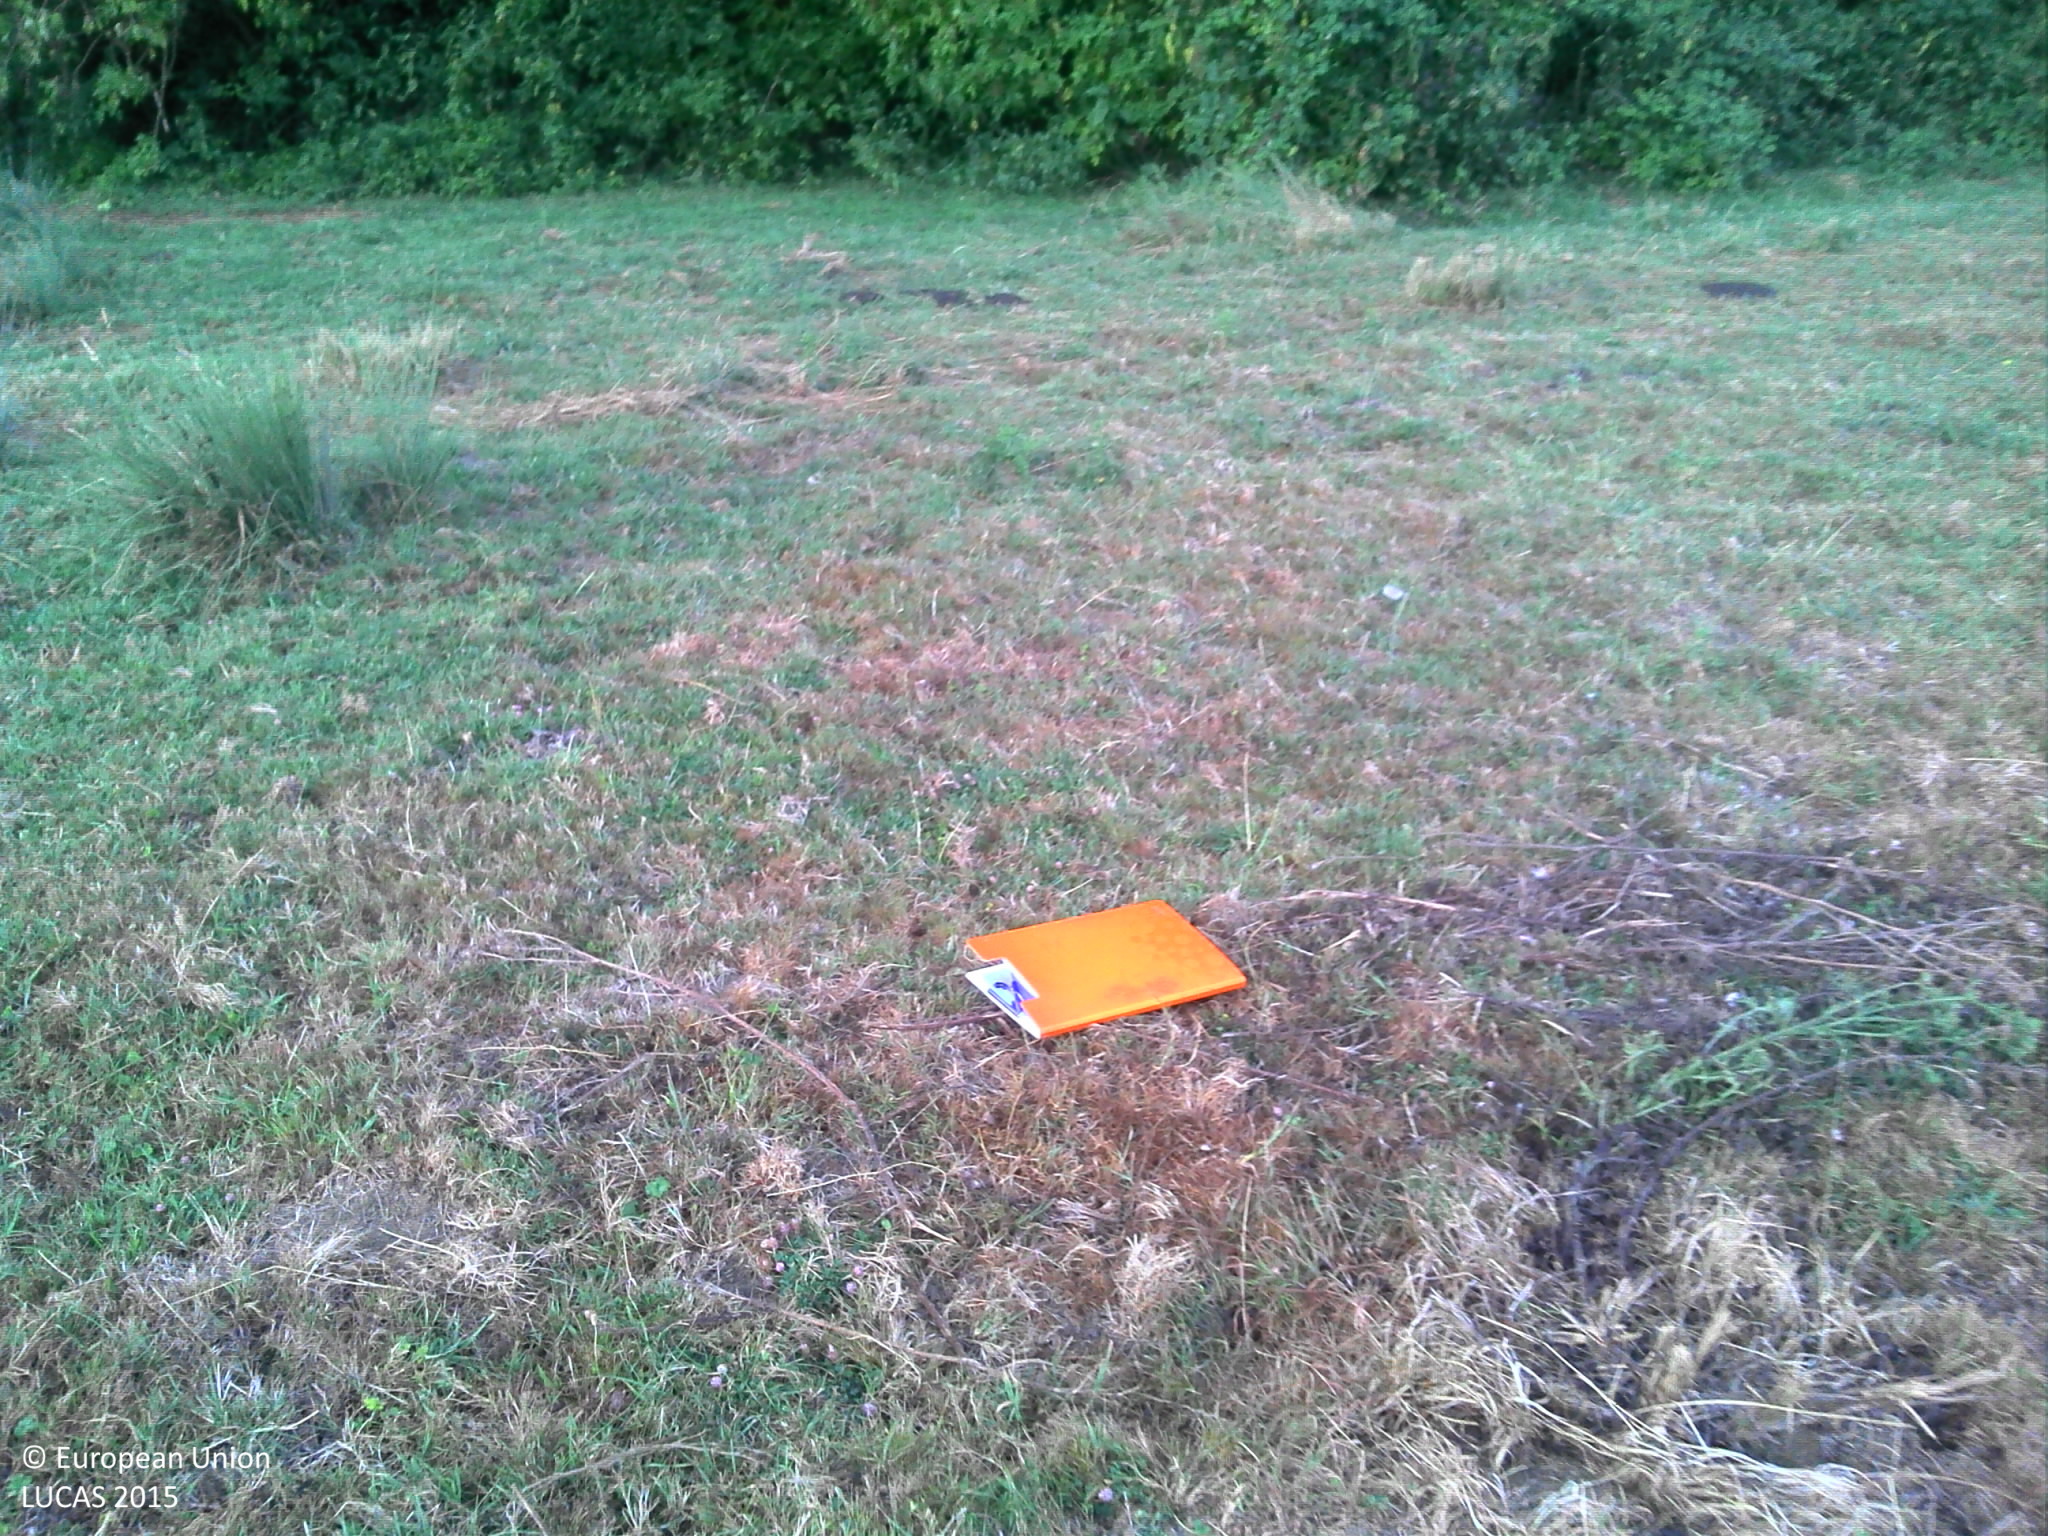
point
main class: Grassland
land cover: Grassland without tree/shrub cover
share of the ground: > 75 %
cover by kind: herbaceous plants 100 %
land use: Agriculture (excluding fallow land and kitchen gardens)
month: July
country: FR
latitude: 47.8747
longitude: 5.3873
